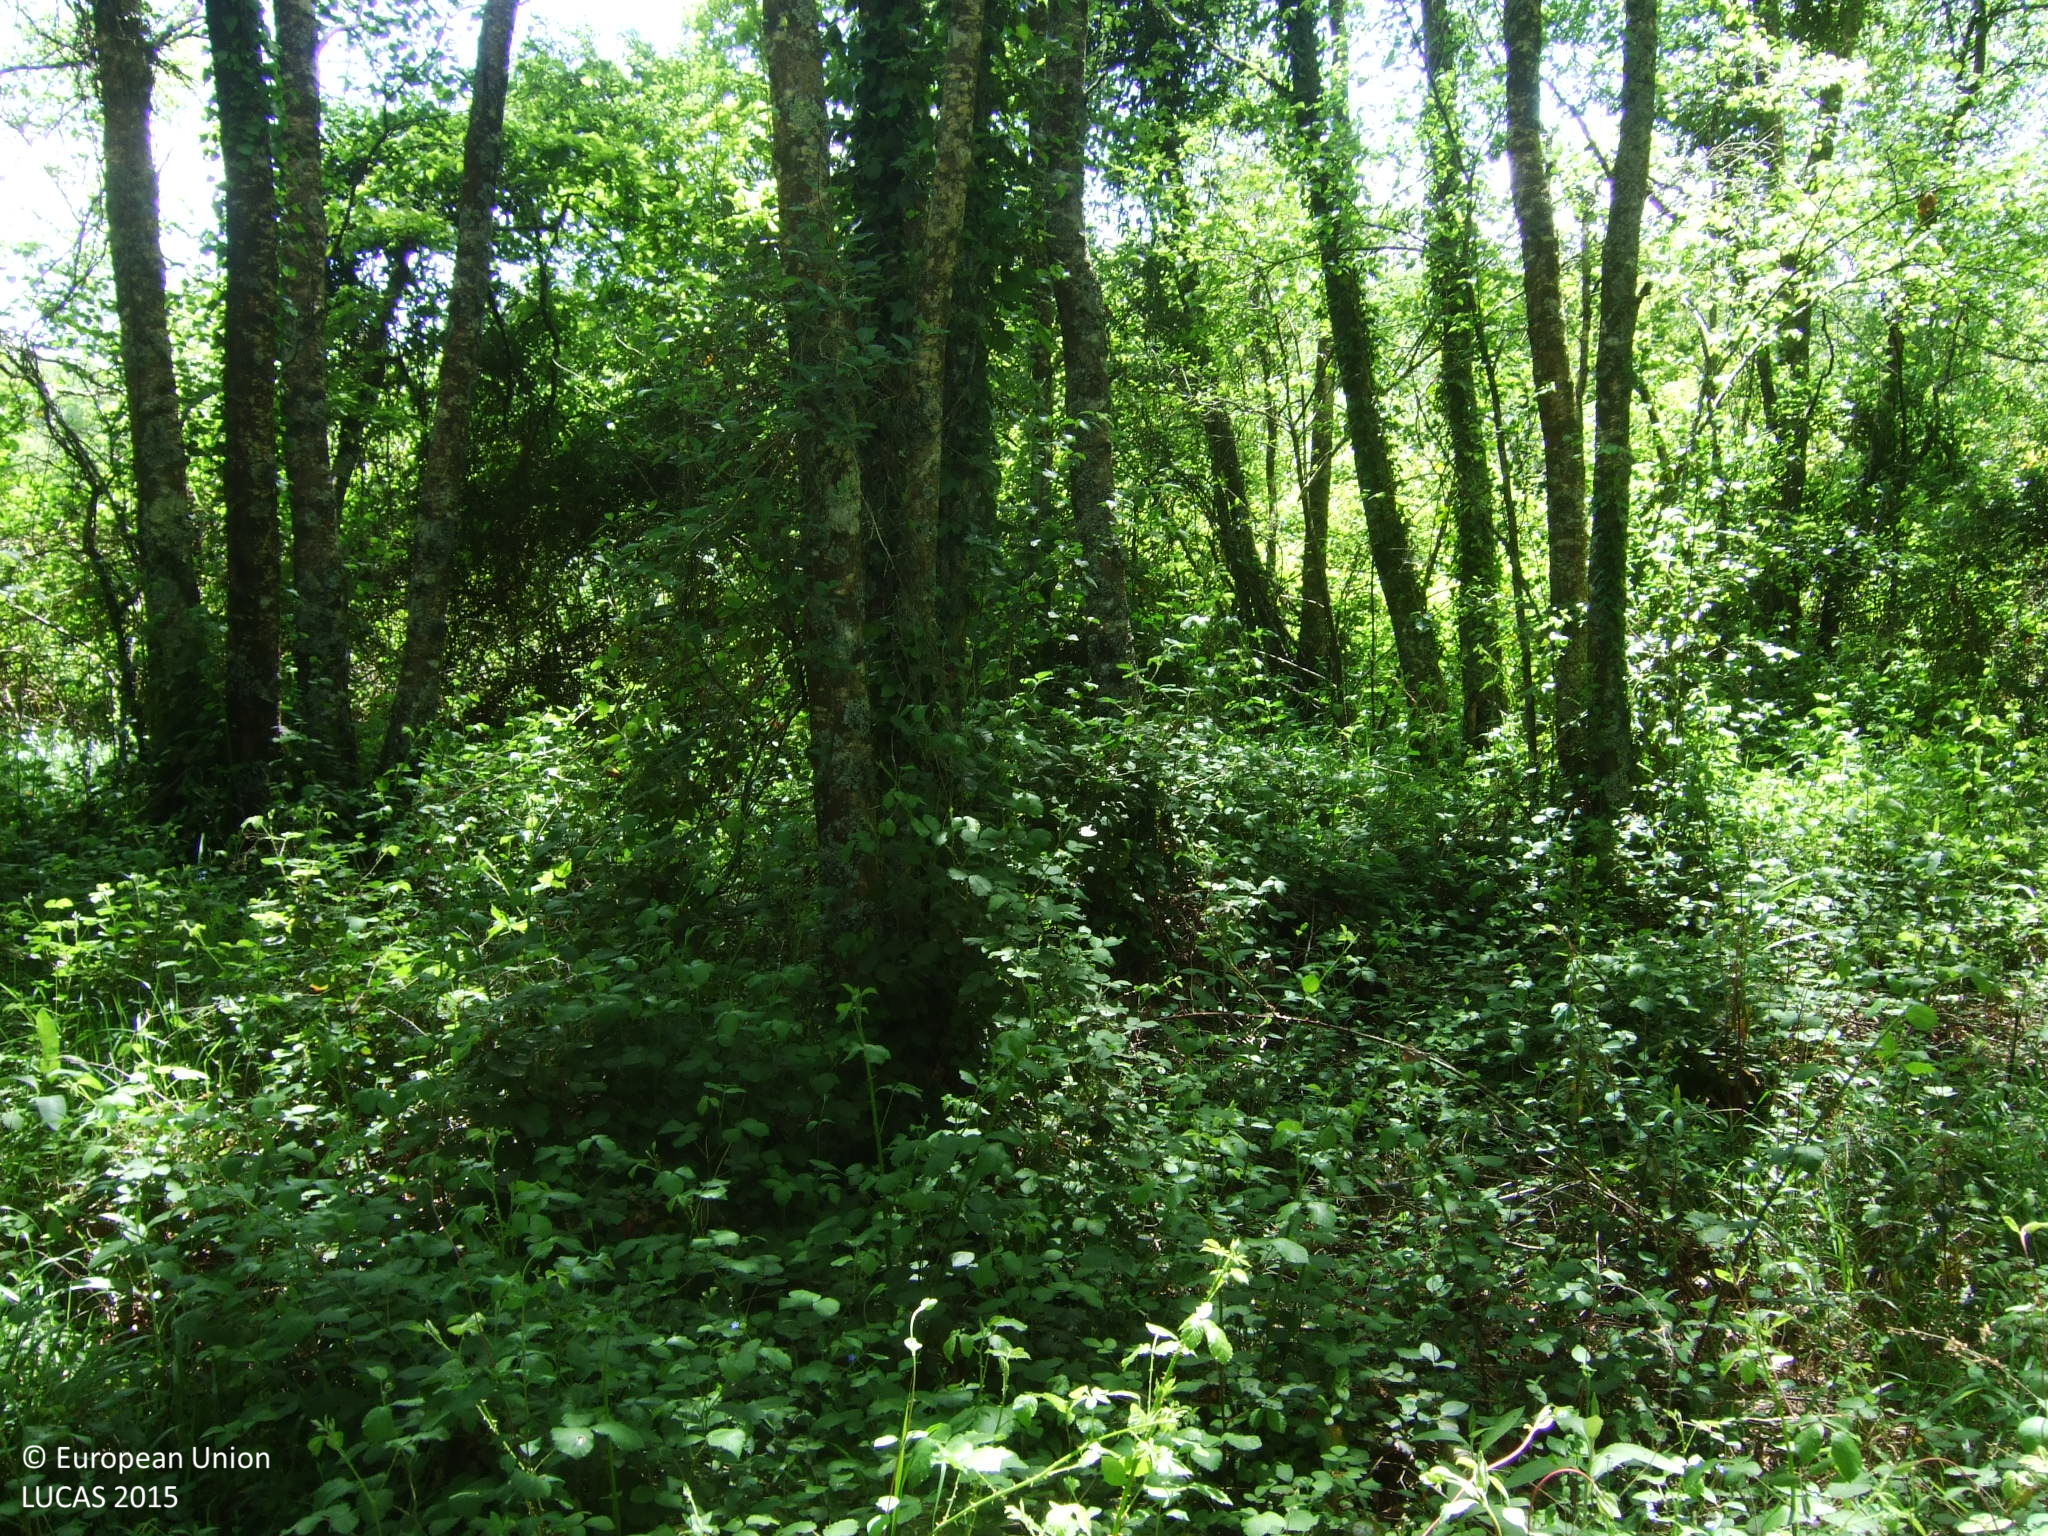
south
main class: Woodland
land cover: Broadleaved woodland
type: acidophilous oak and oak-birch forest
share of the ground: > 75 %
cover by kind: broadleaved forest trees 85 %, shrubs 15 %
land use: Semi-natural and natural areas not in use
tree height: > 5 m
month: May
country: ES
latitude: 43.2984
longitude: -7.7756
